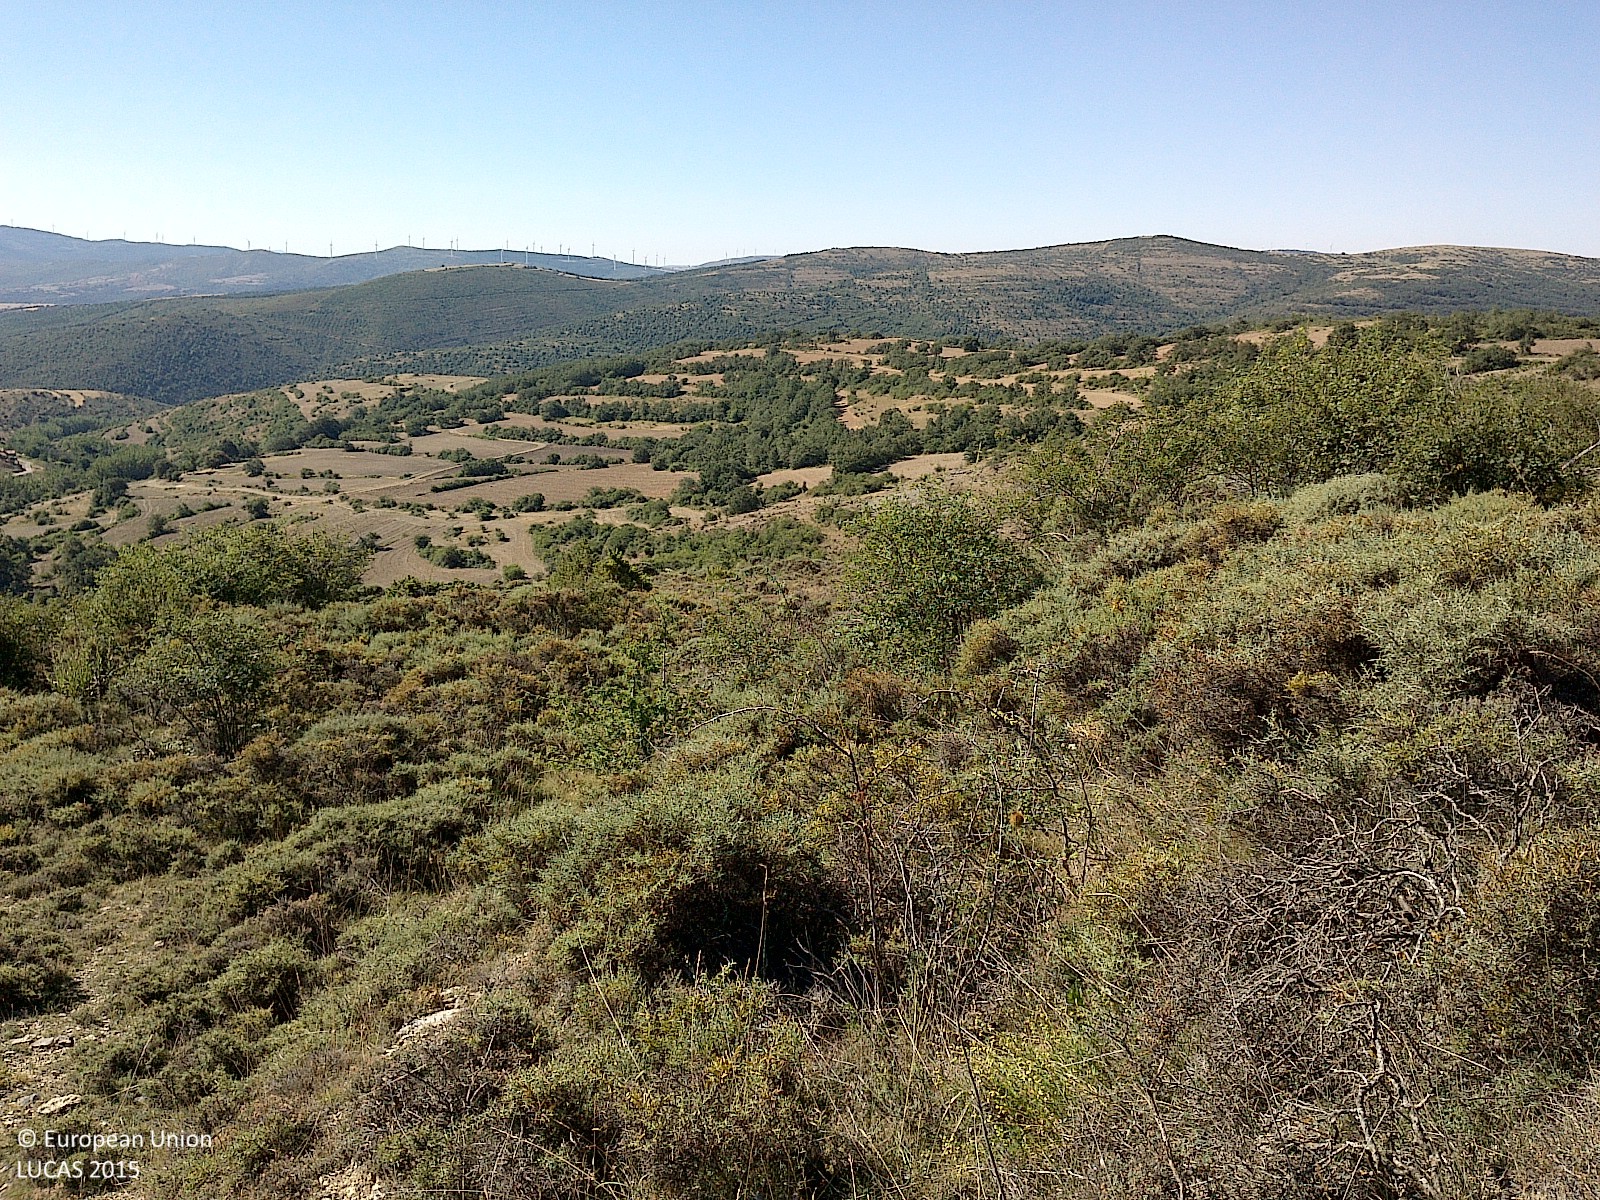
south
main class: Shrubland
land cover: Shrubland without tree cover
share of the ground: 50 - 75 %
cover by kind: shrubs 65 %, herbaceous plants 25 %, consolidated bare surface 5 %, unconsolidated bare surface 5 %
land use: Agriculture (excluding fallow land and kitchen gardens)
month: July
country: ES
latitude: 41.9461
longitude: -2.2325
